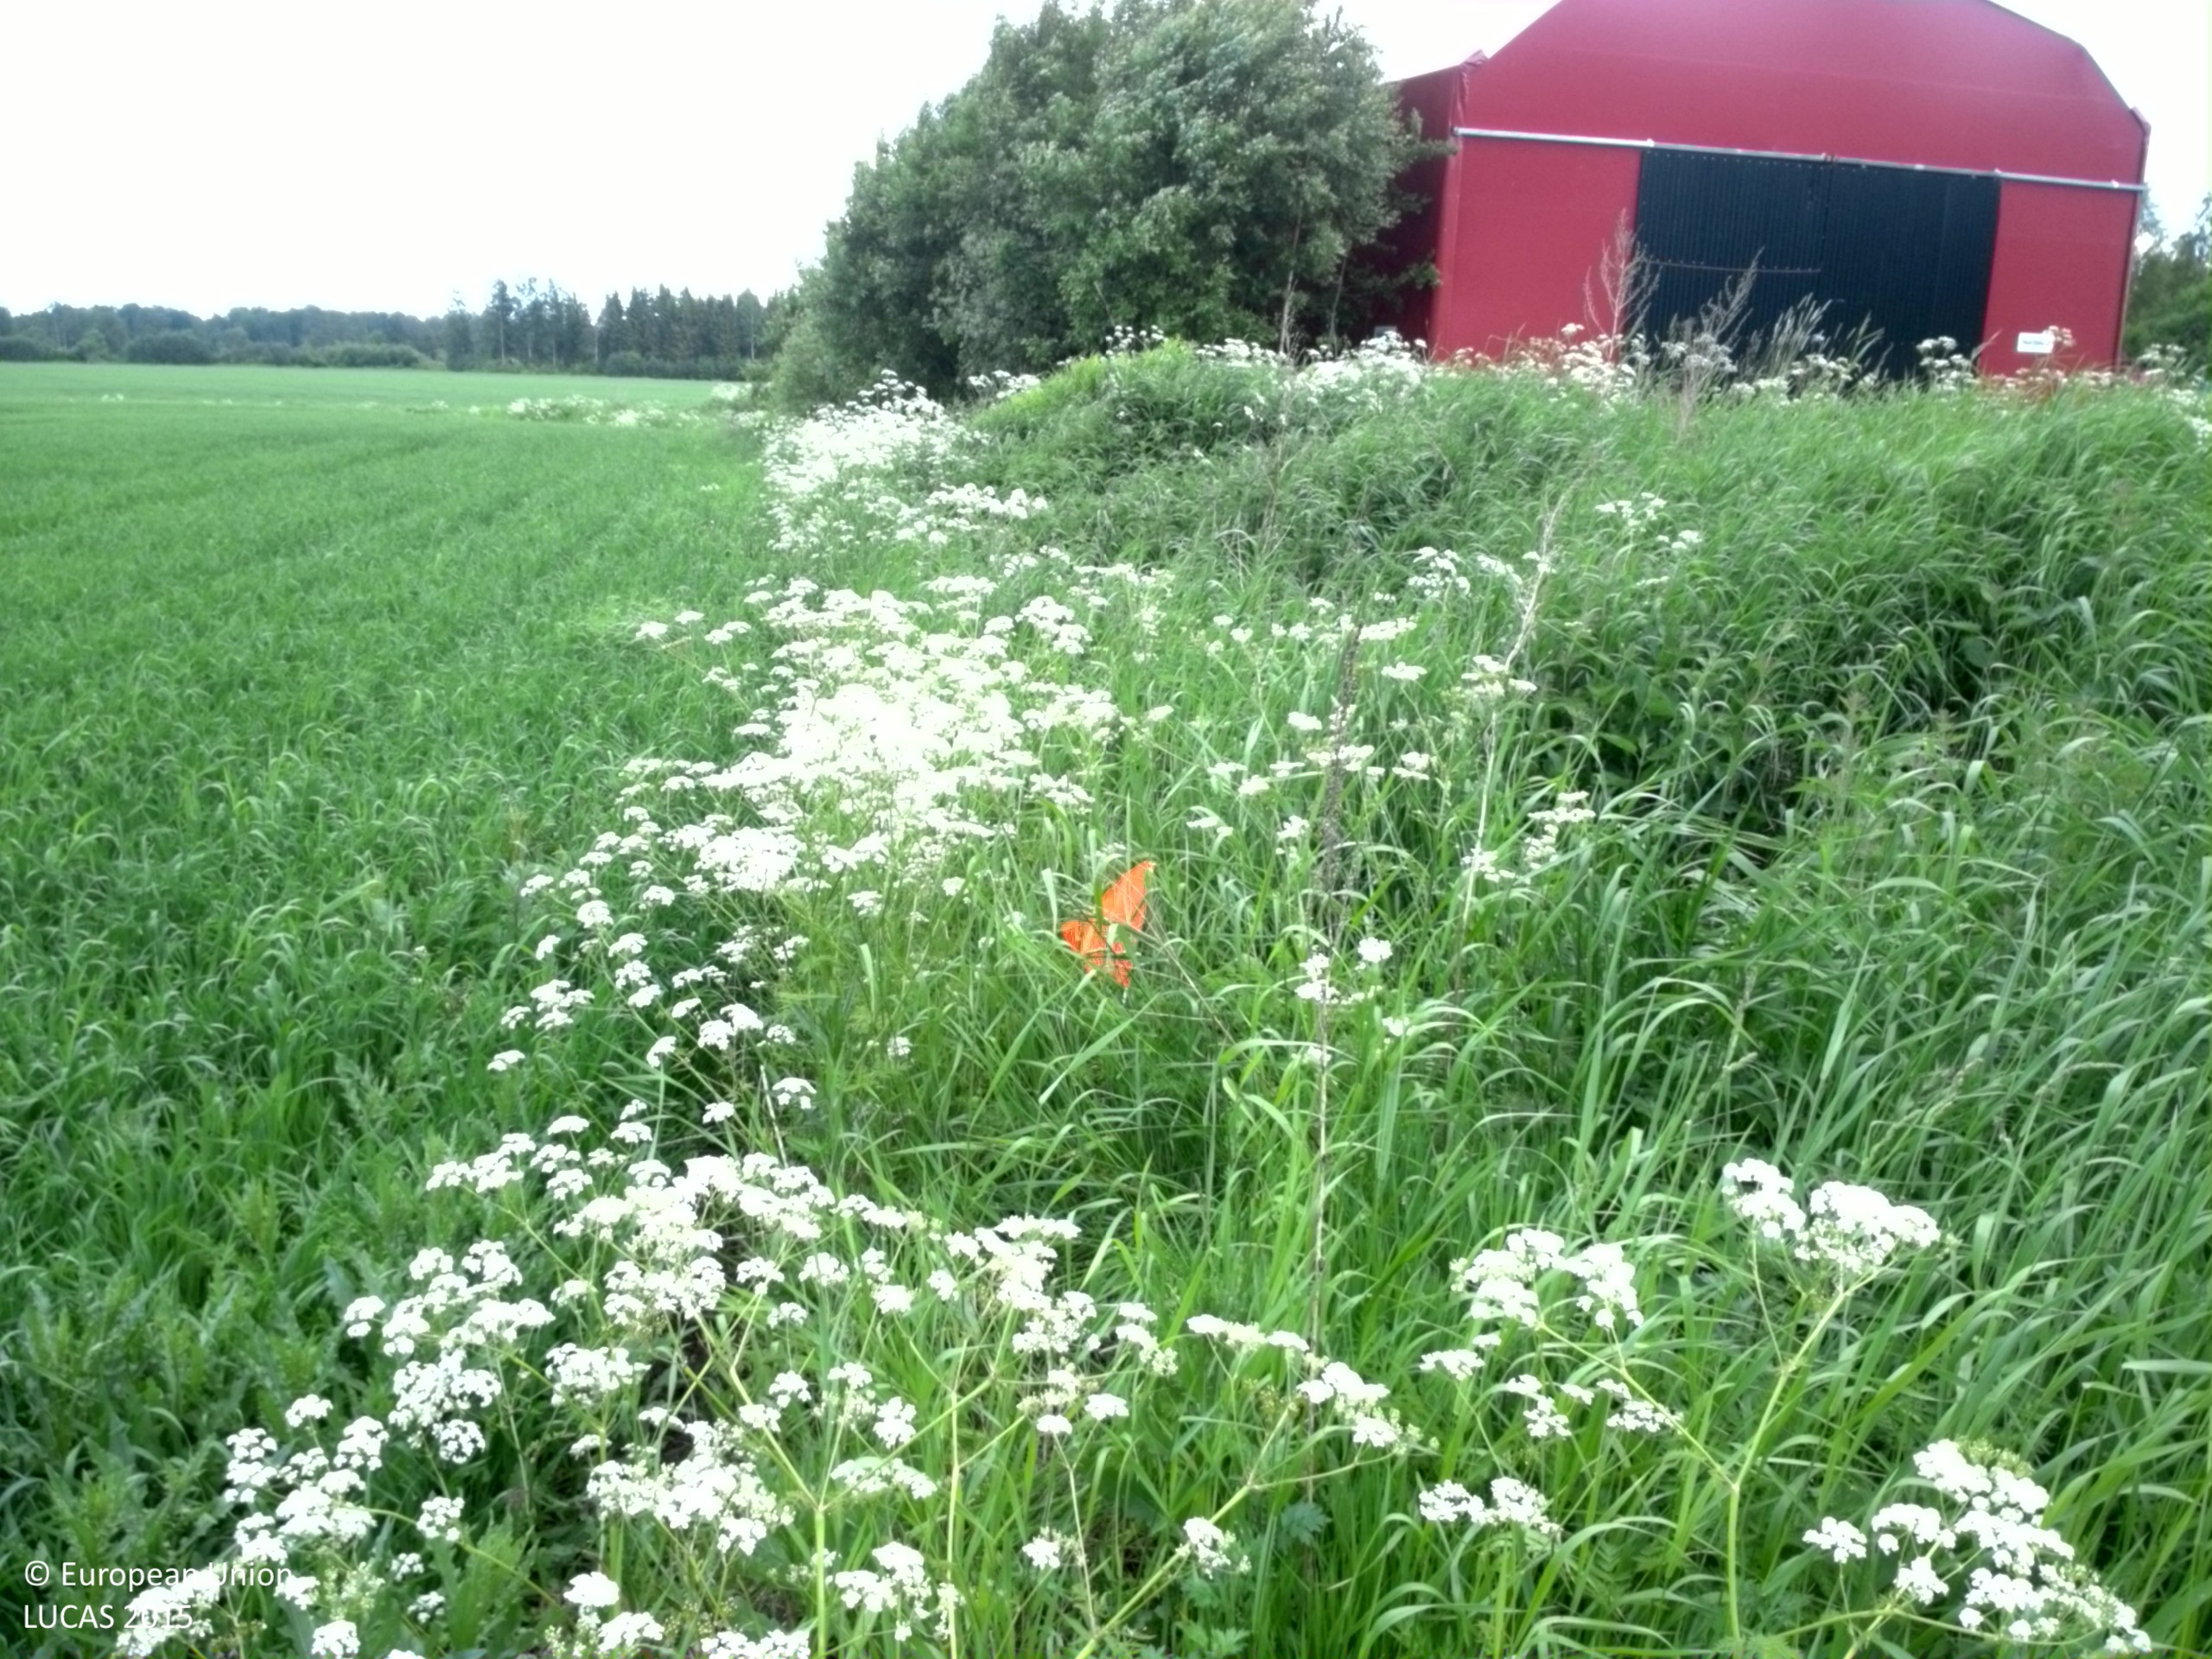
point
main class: Cropland
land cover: Common wheat
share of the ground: > 75 %
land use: Agriculture (excluding fallow land and kitchen gardens)
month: June
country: SE
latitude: 60.4279
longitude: 17.6028
